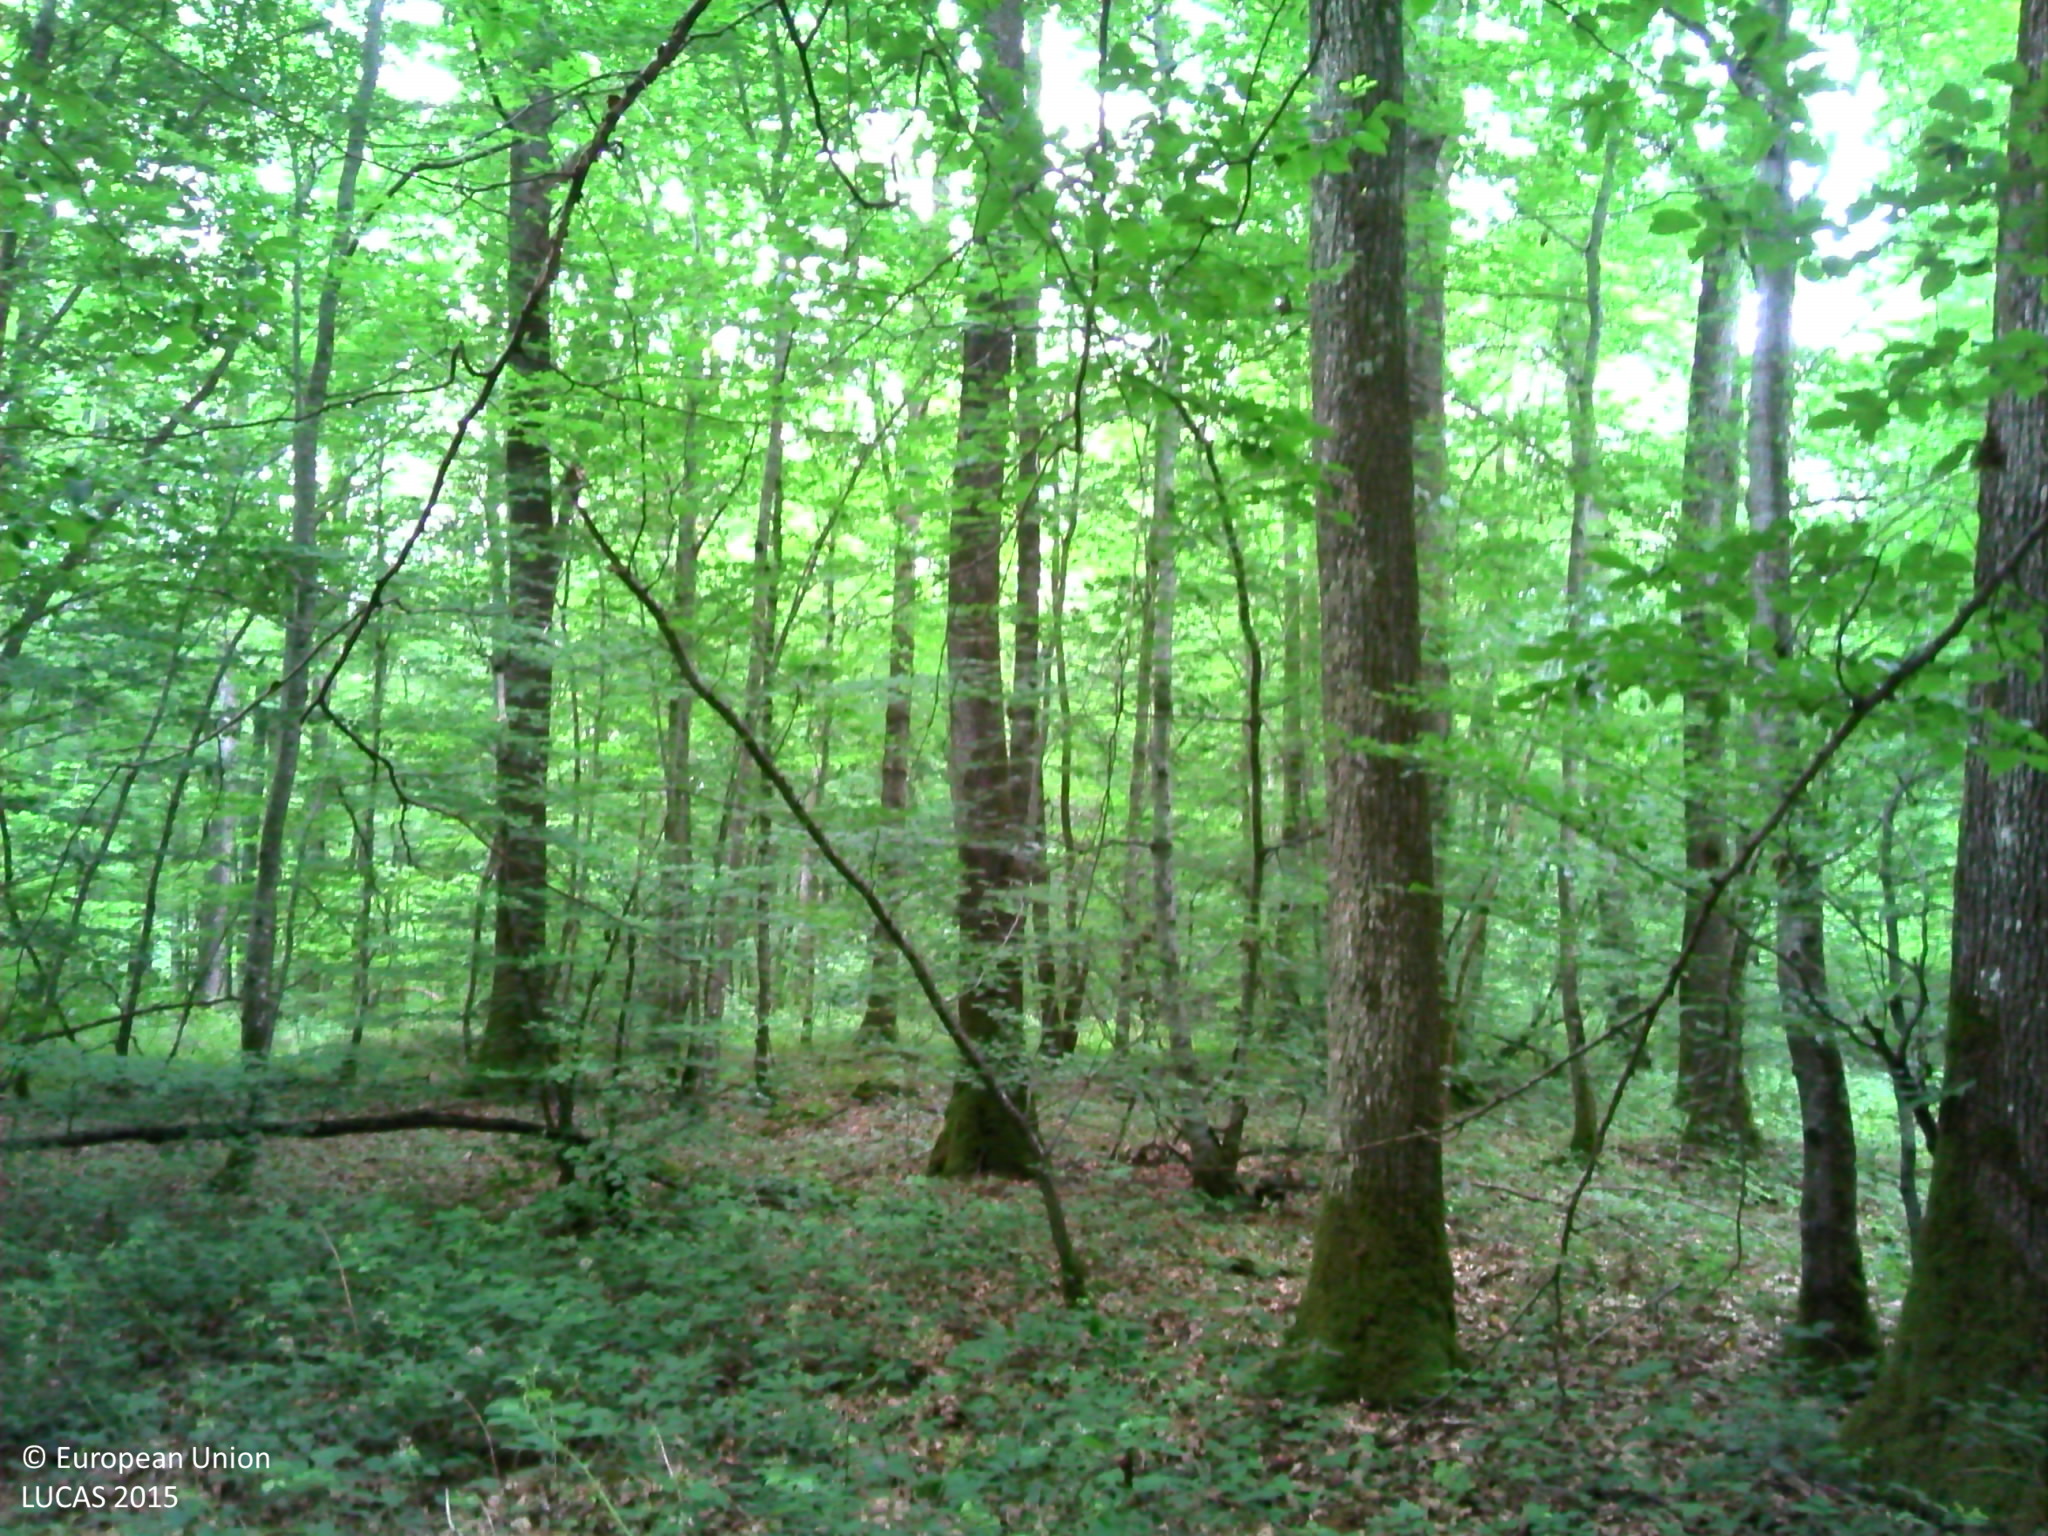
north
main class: Woodland
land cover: Broadleaved woodland
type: mesophytic deciduous forest
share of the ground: > 75 %
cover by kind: broadleaved forest trees 100 %
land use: Forestry
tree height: > 5 m
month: June
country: FR
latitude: 47.3423
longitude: 3.1524
